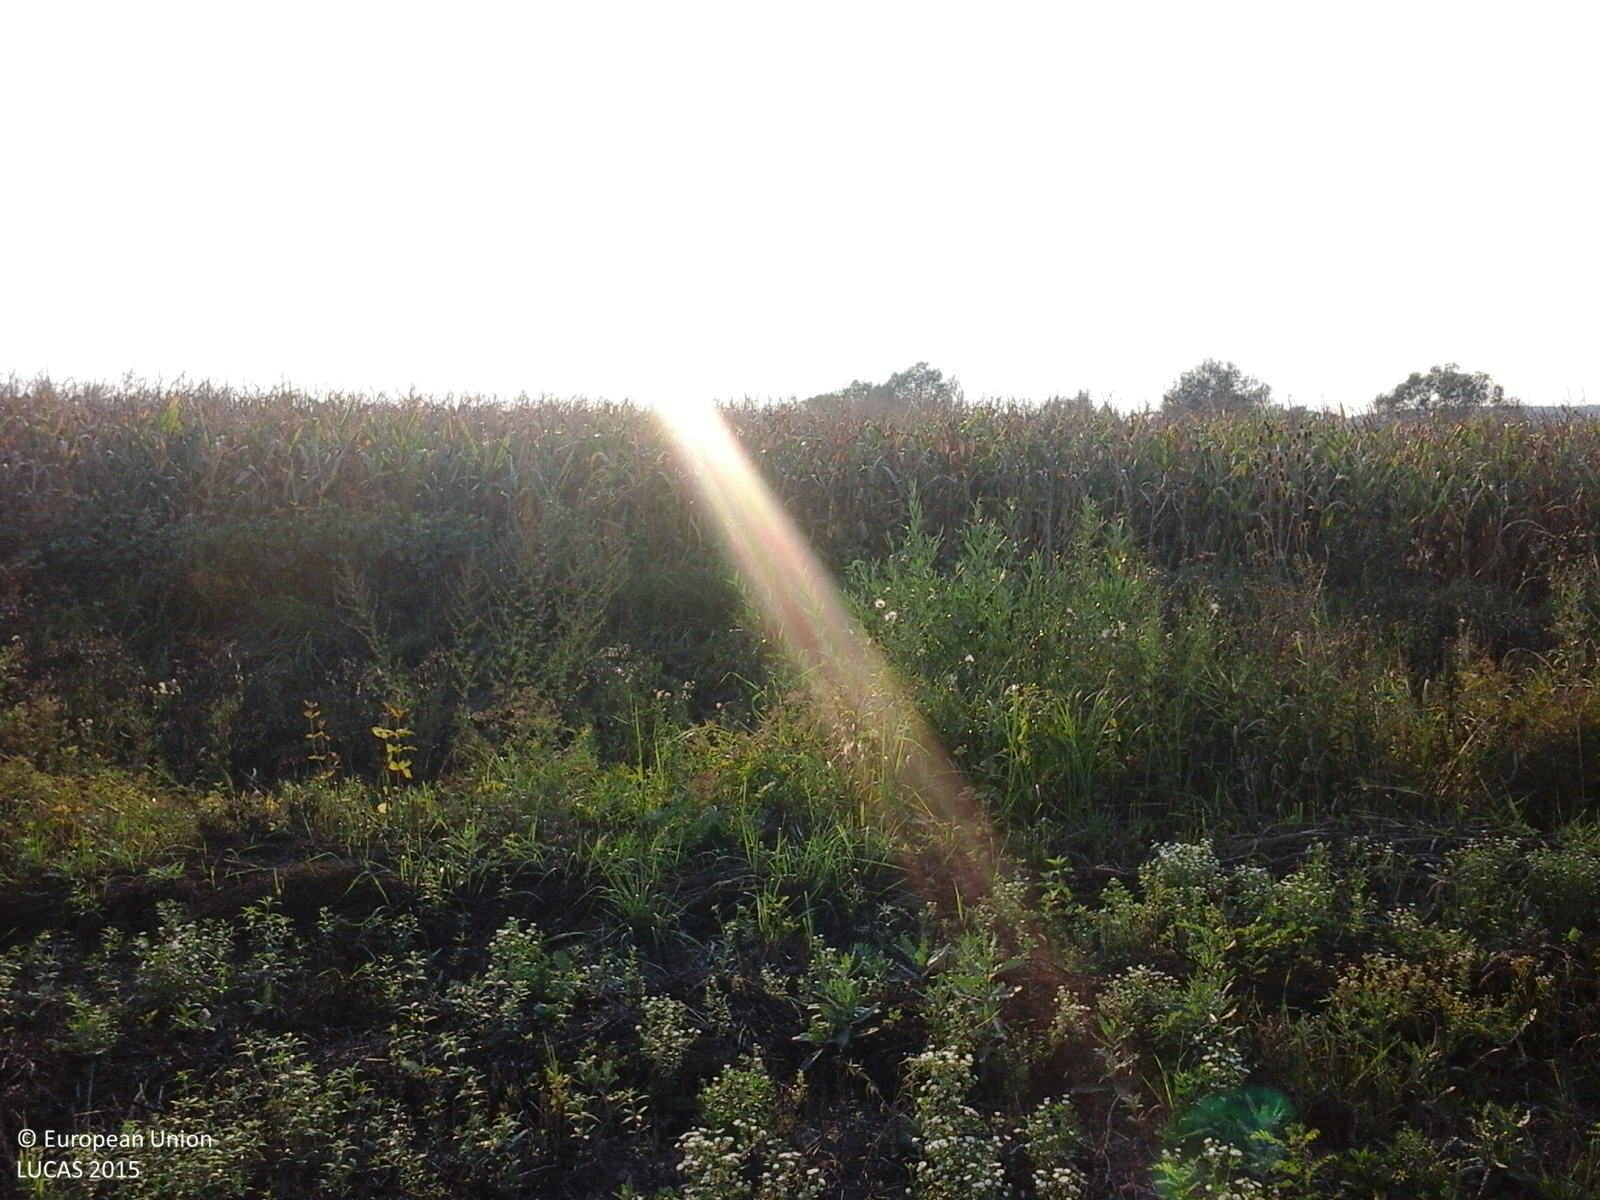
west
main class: Cropland
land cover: Maize
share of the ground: > 75 %
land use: Agriculture (excluding fallow land and kitchen gardens)
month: August
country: RO
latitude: 46.0260
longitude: 22.0959
